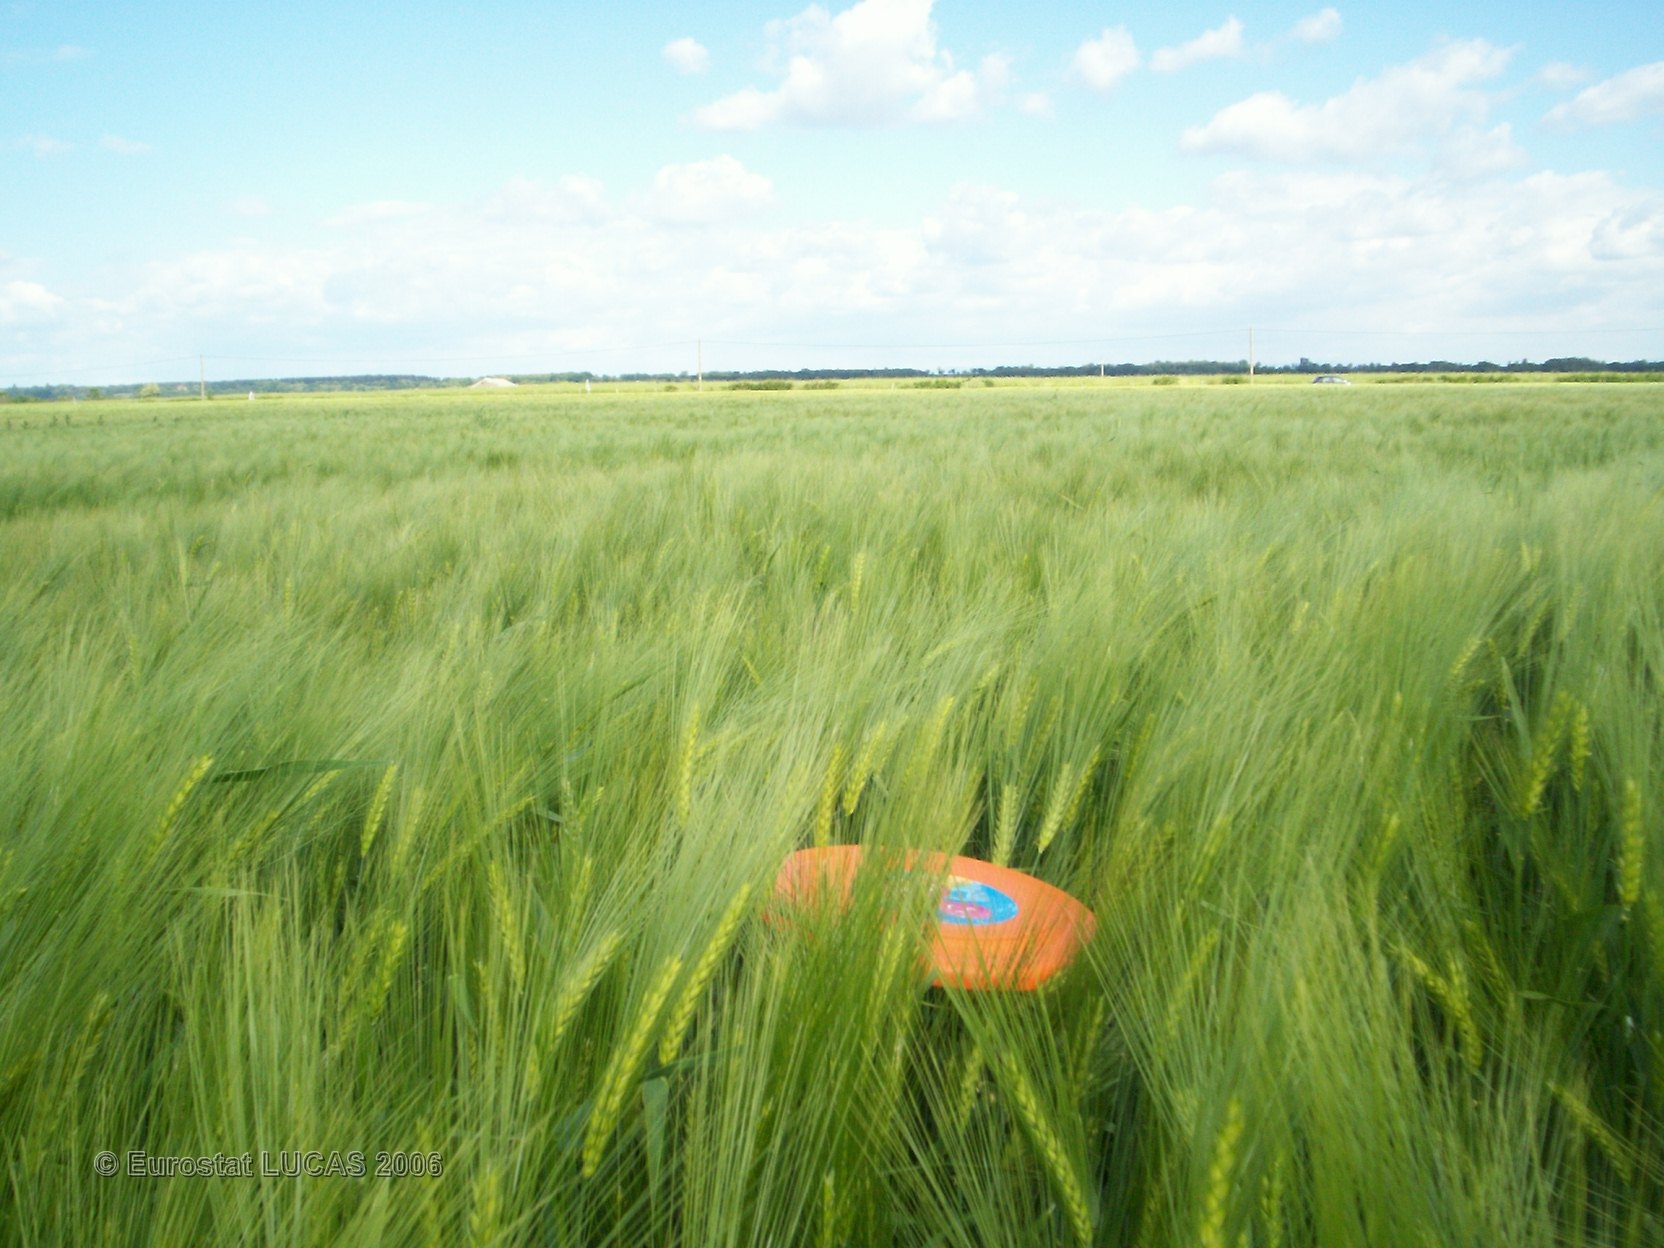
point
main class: Cropland
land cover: Barley
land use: Agriculture (excluding fallow land and kitchen gardens)
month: June
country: FR
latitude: 46.1904
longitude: 3.2224
